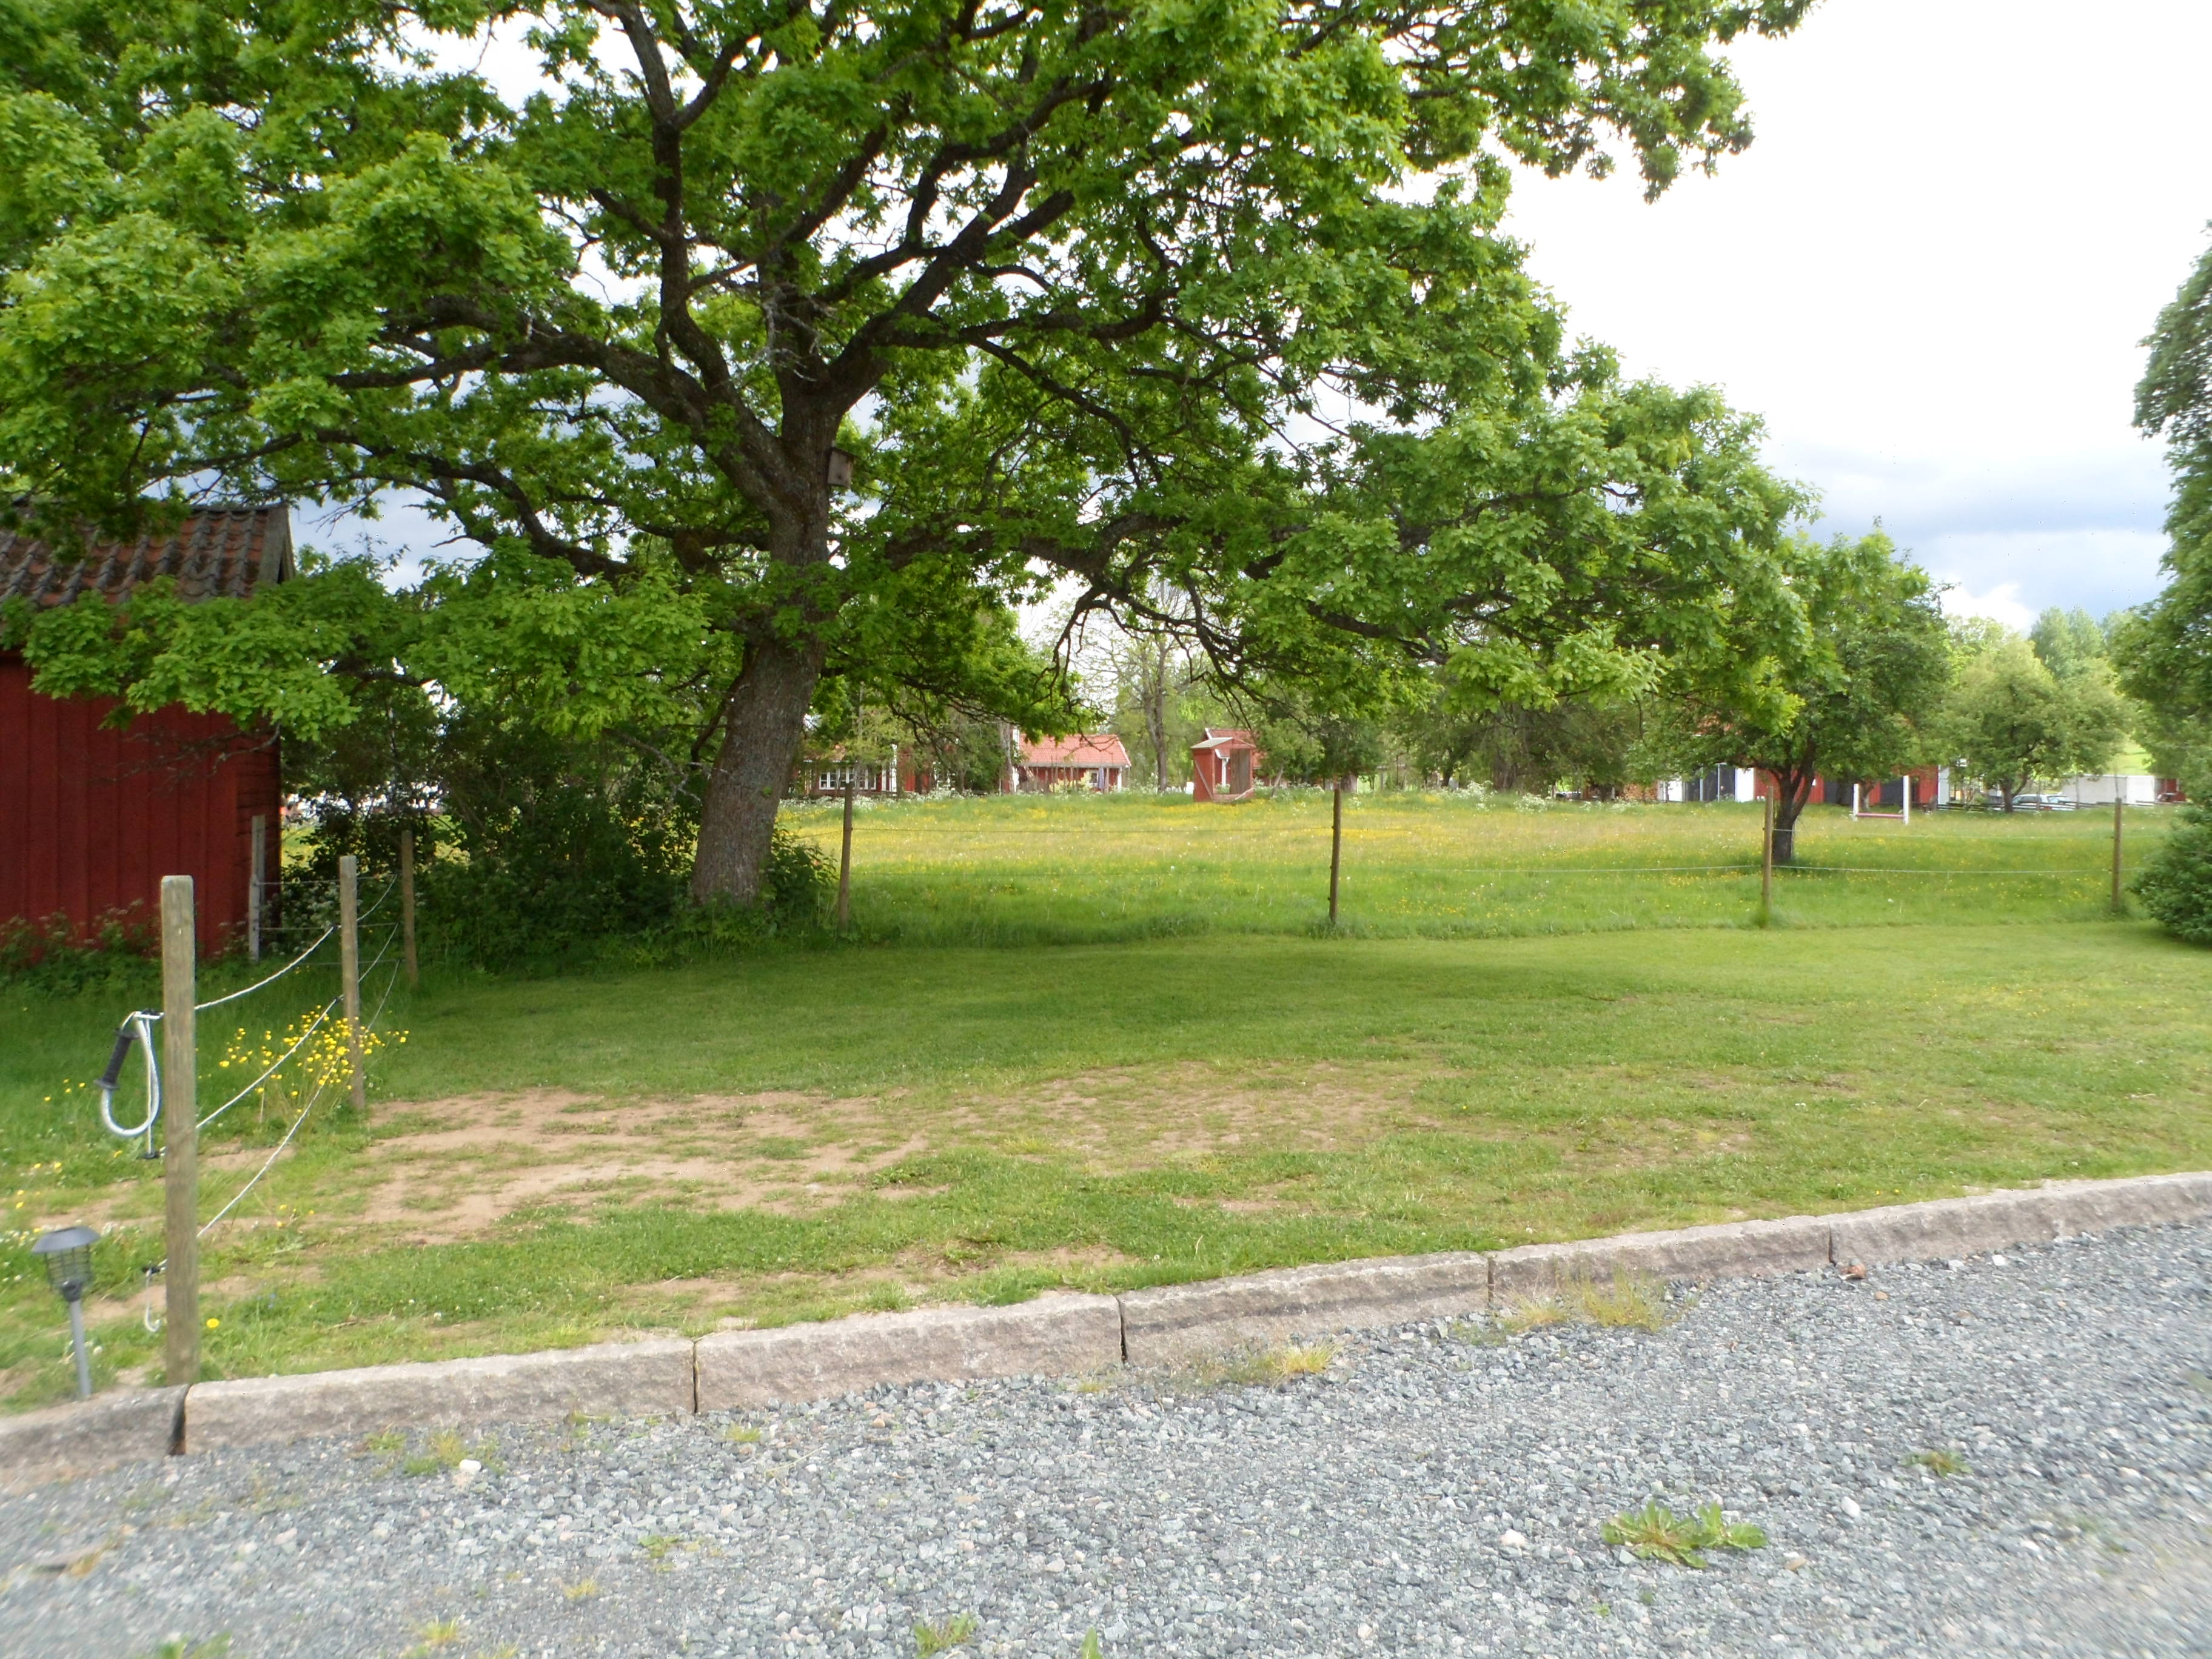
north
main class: Grassland
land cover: Grassland without tree/shrub cover
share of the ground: > 75 %
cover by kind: herbaceous plants 100 %
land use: Residential
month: June
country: SE
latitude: 57.4163
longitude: 14.1746
